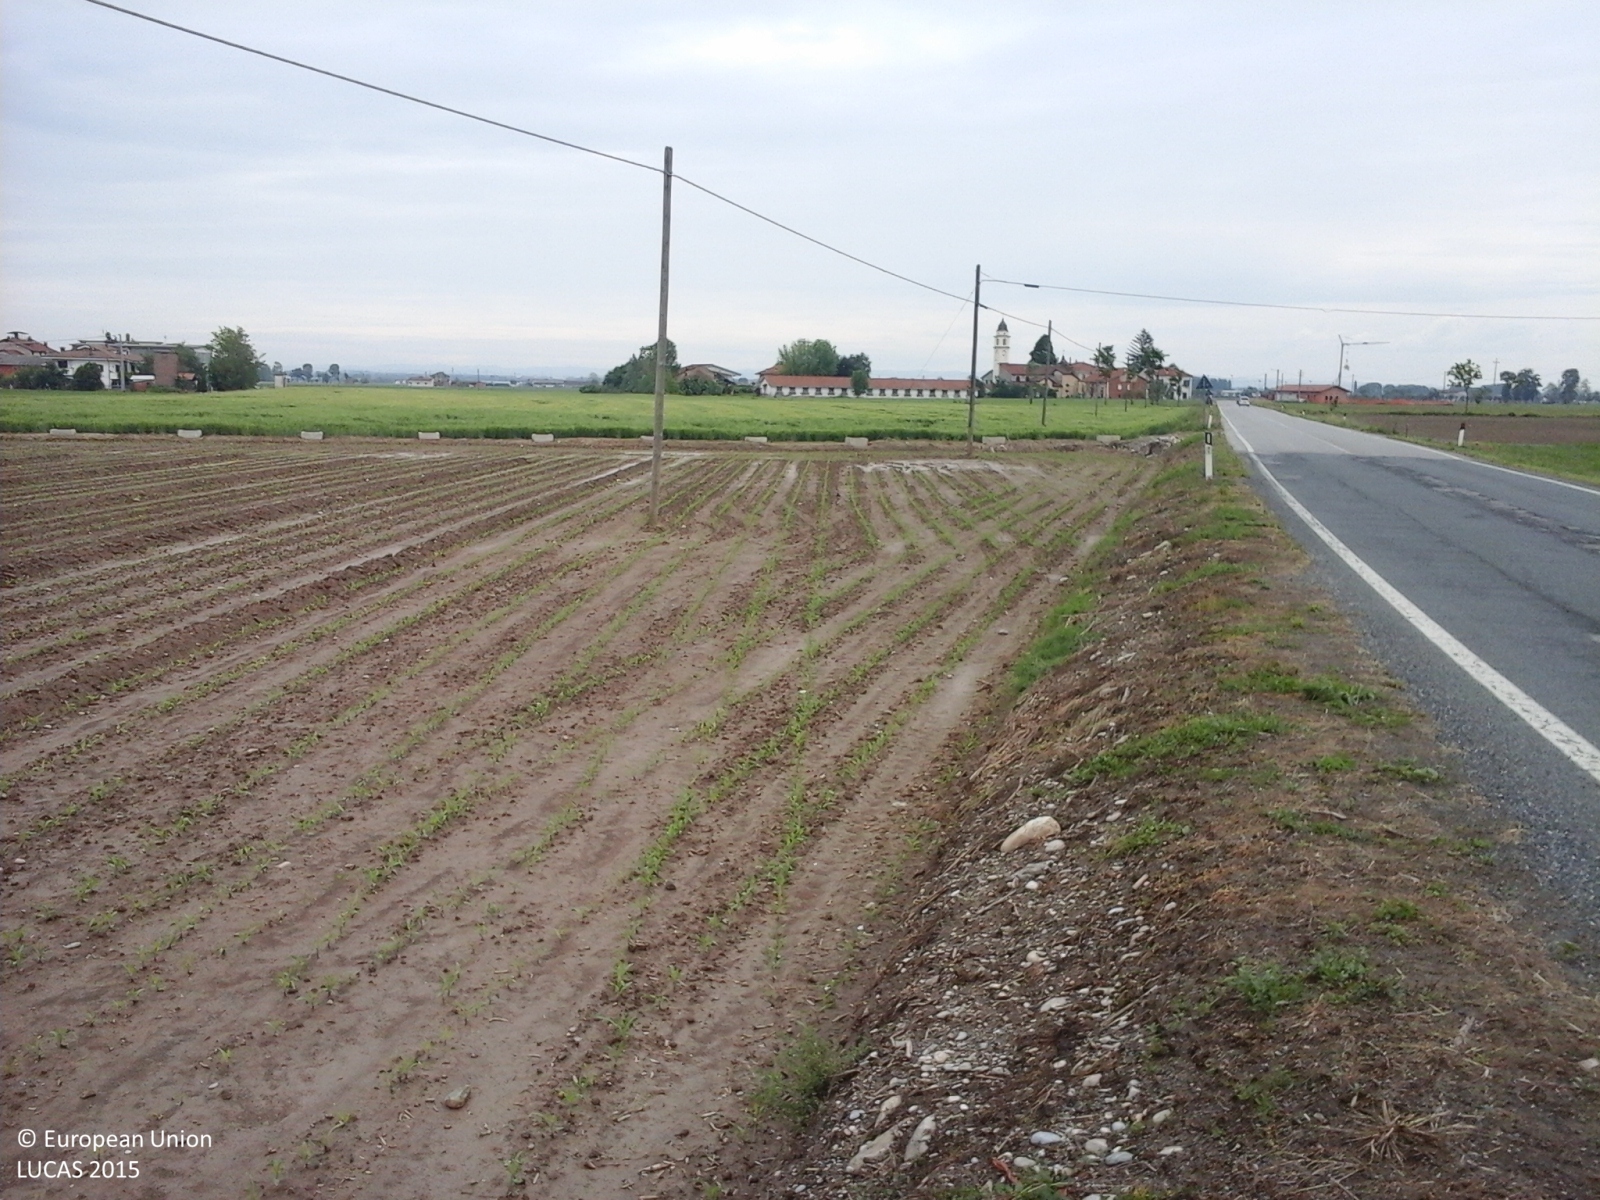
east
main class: Cropland
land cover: Maize
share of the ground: < 10 %
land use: Agriculture (excluding fallow land and kitchen gardens)
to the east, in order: Maize; Ditches and canals; Barley
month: May
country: IT
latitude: 44.5585
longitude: 7.6505
